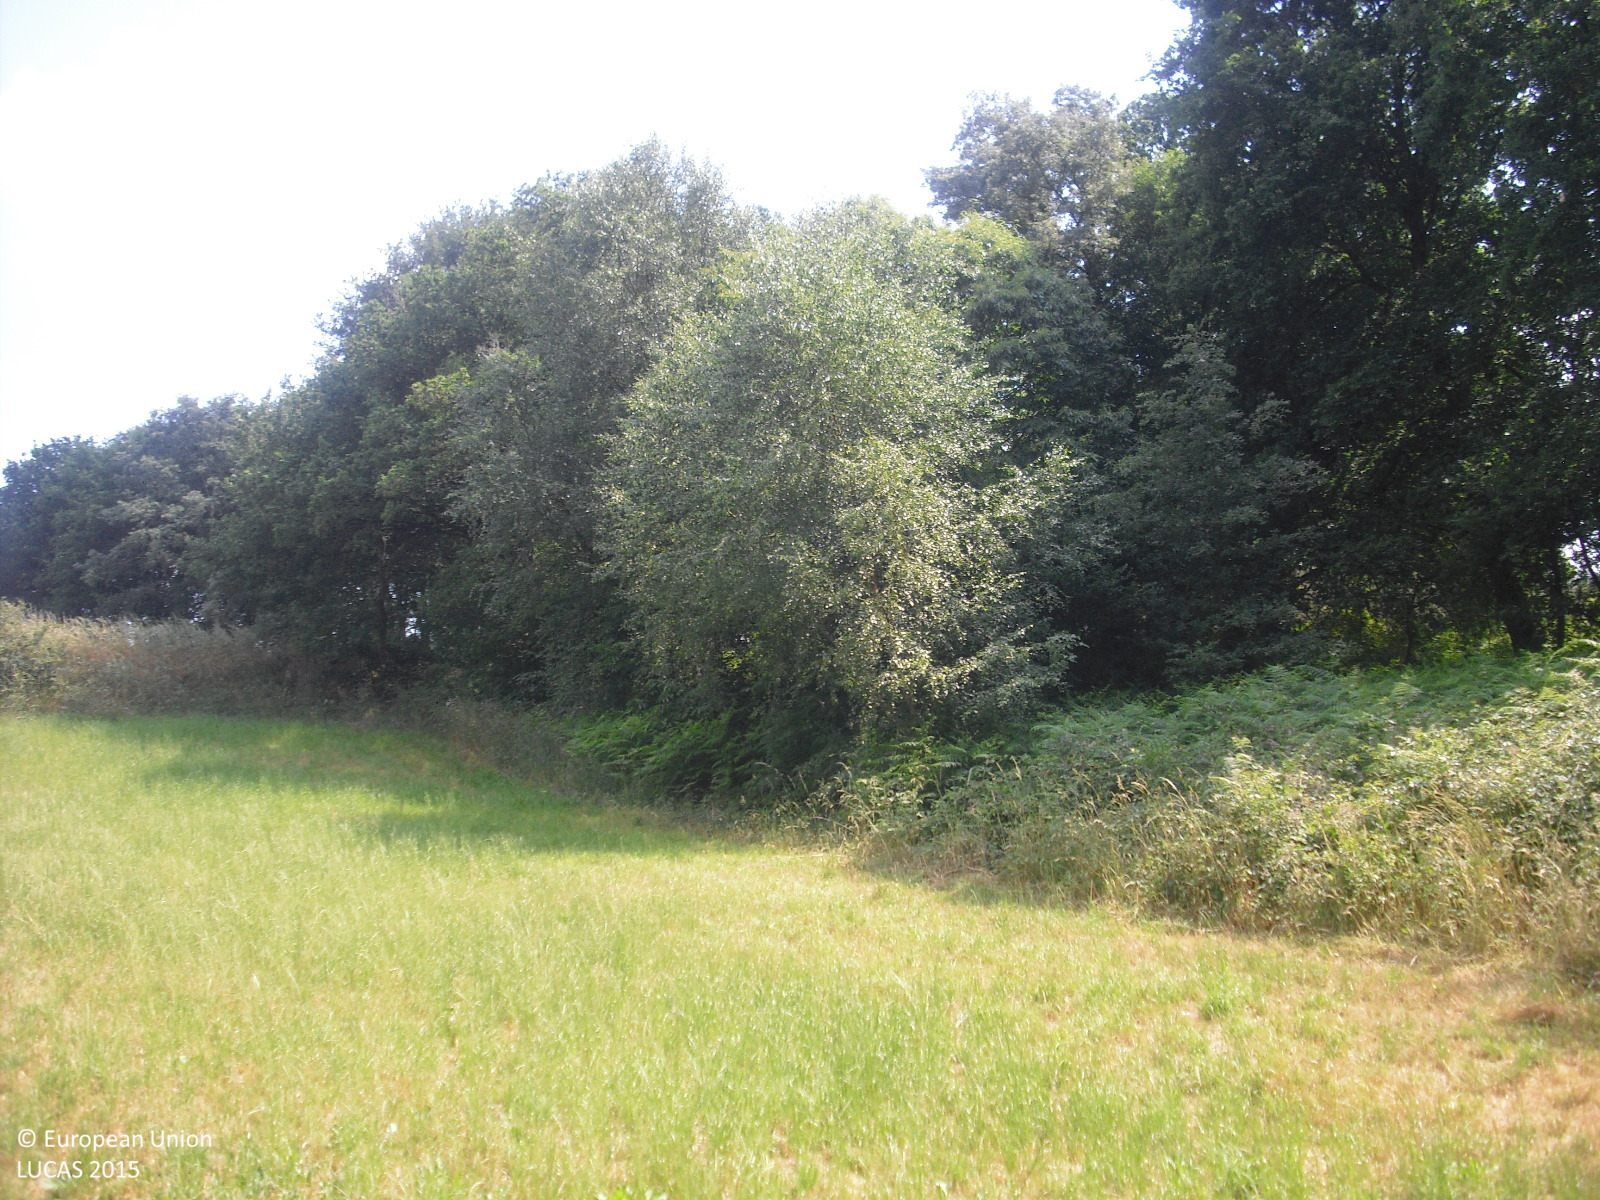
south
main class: Cropland
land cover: Temporary grasslands
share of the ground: > 75 %
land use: Agriculture (excluding fallow land and kitchen gardens)
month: June
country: ES
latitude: 42.6308
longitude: -7.7970
